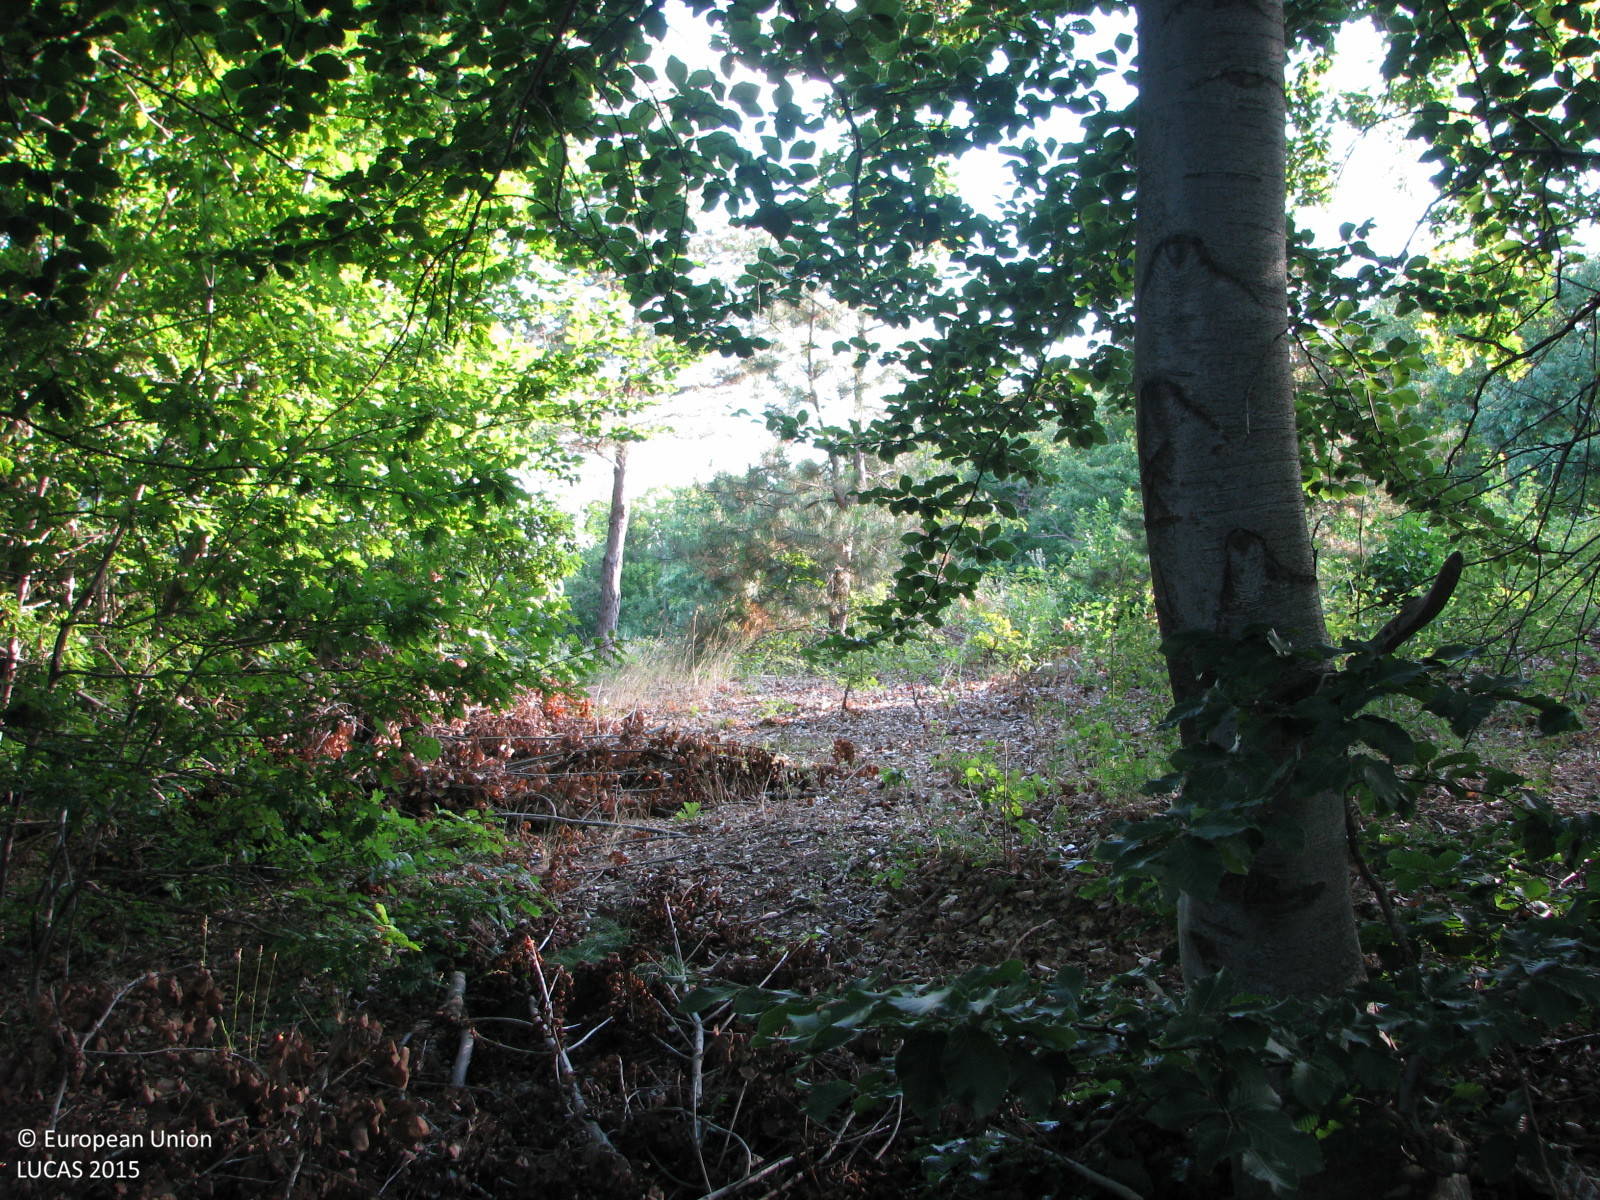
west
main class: Woodland
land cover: Broadleaved woodland
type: beech forest
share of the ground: 50 - 75 %
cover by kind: broadleaved forest trees 70 %, unconsolidated bare surface 20 %, shrubs 5 %, herbaceous plants 5 %
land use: Forestry
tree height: > 5 m
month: August
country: BG
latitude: 42.7212
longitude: 26.2952
